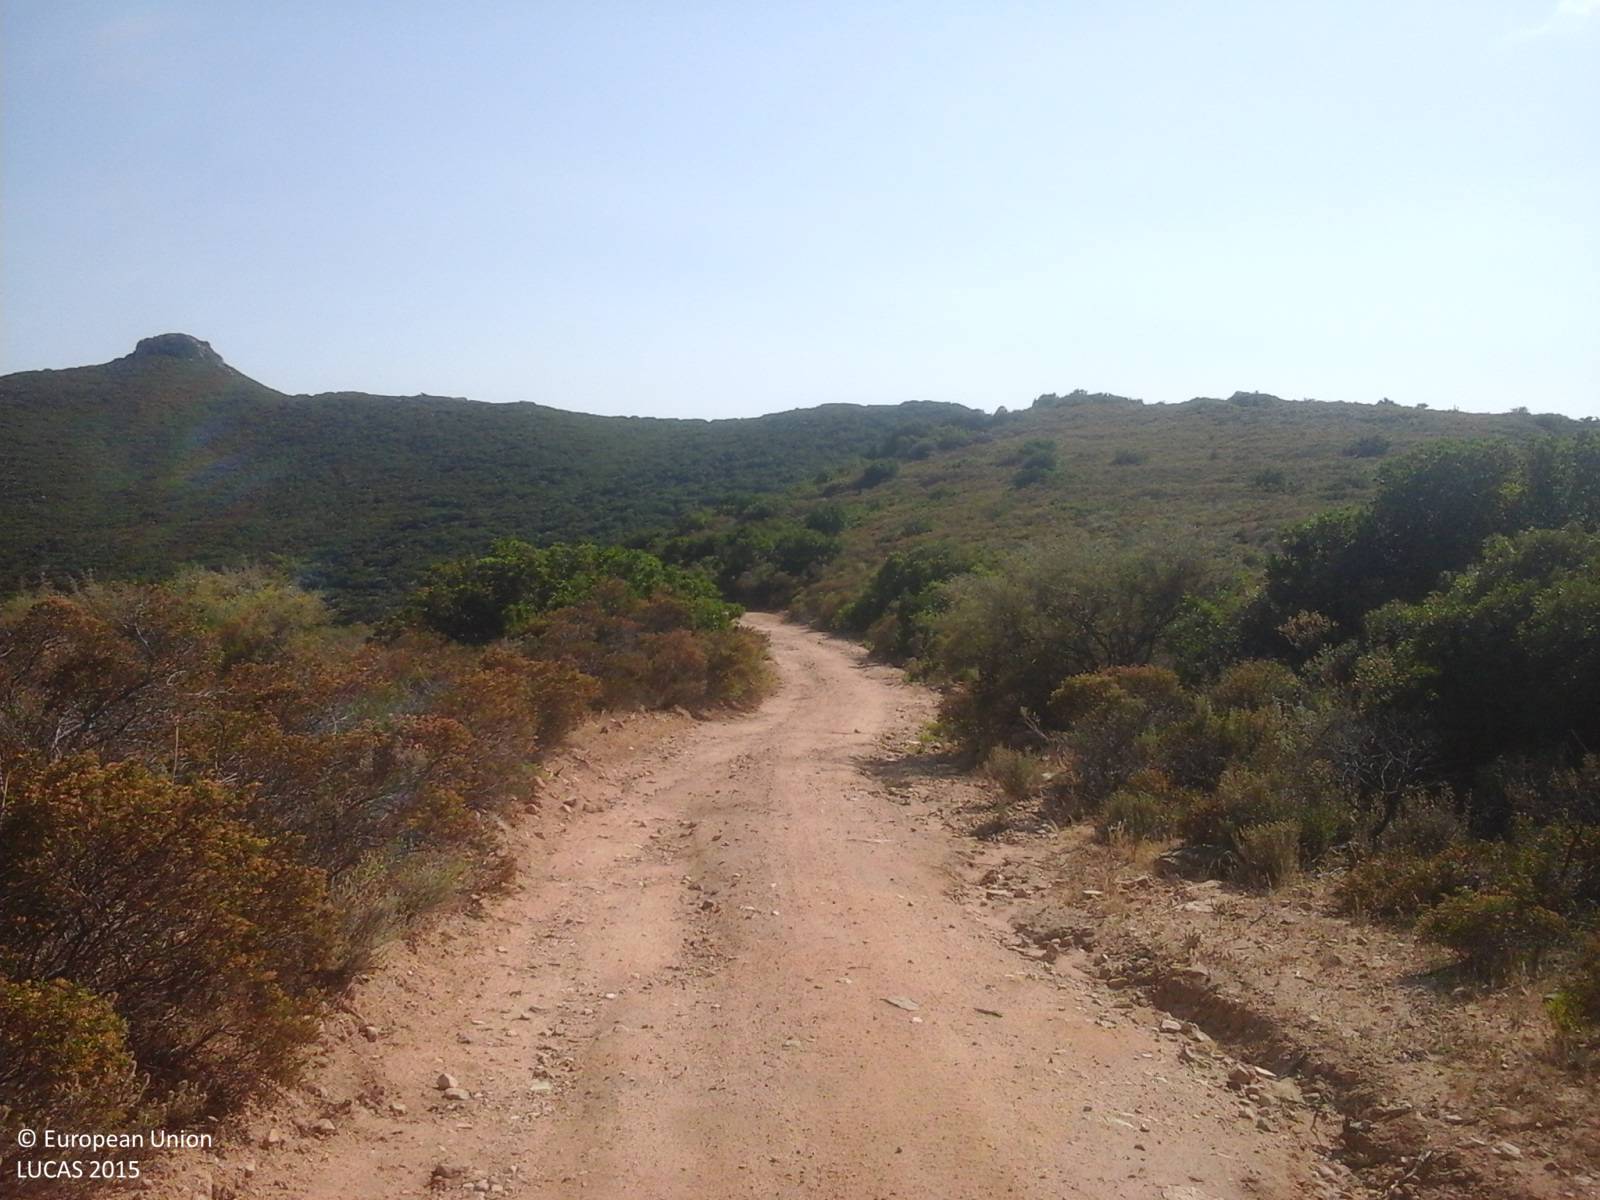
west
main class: Shrubland
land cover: Shrubland without tree cover
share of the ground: > 75 %
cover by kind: shrubs 90 %, herbaceous plants 10 %
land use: Agriculture (excluding fallow land and kitchen gardens)
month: June
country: IT
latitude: 39.2150
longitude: 9.4130
